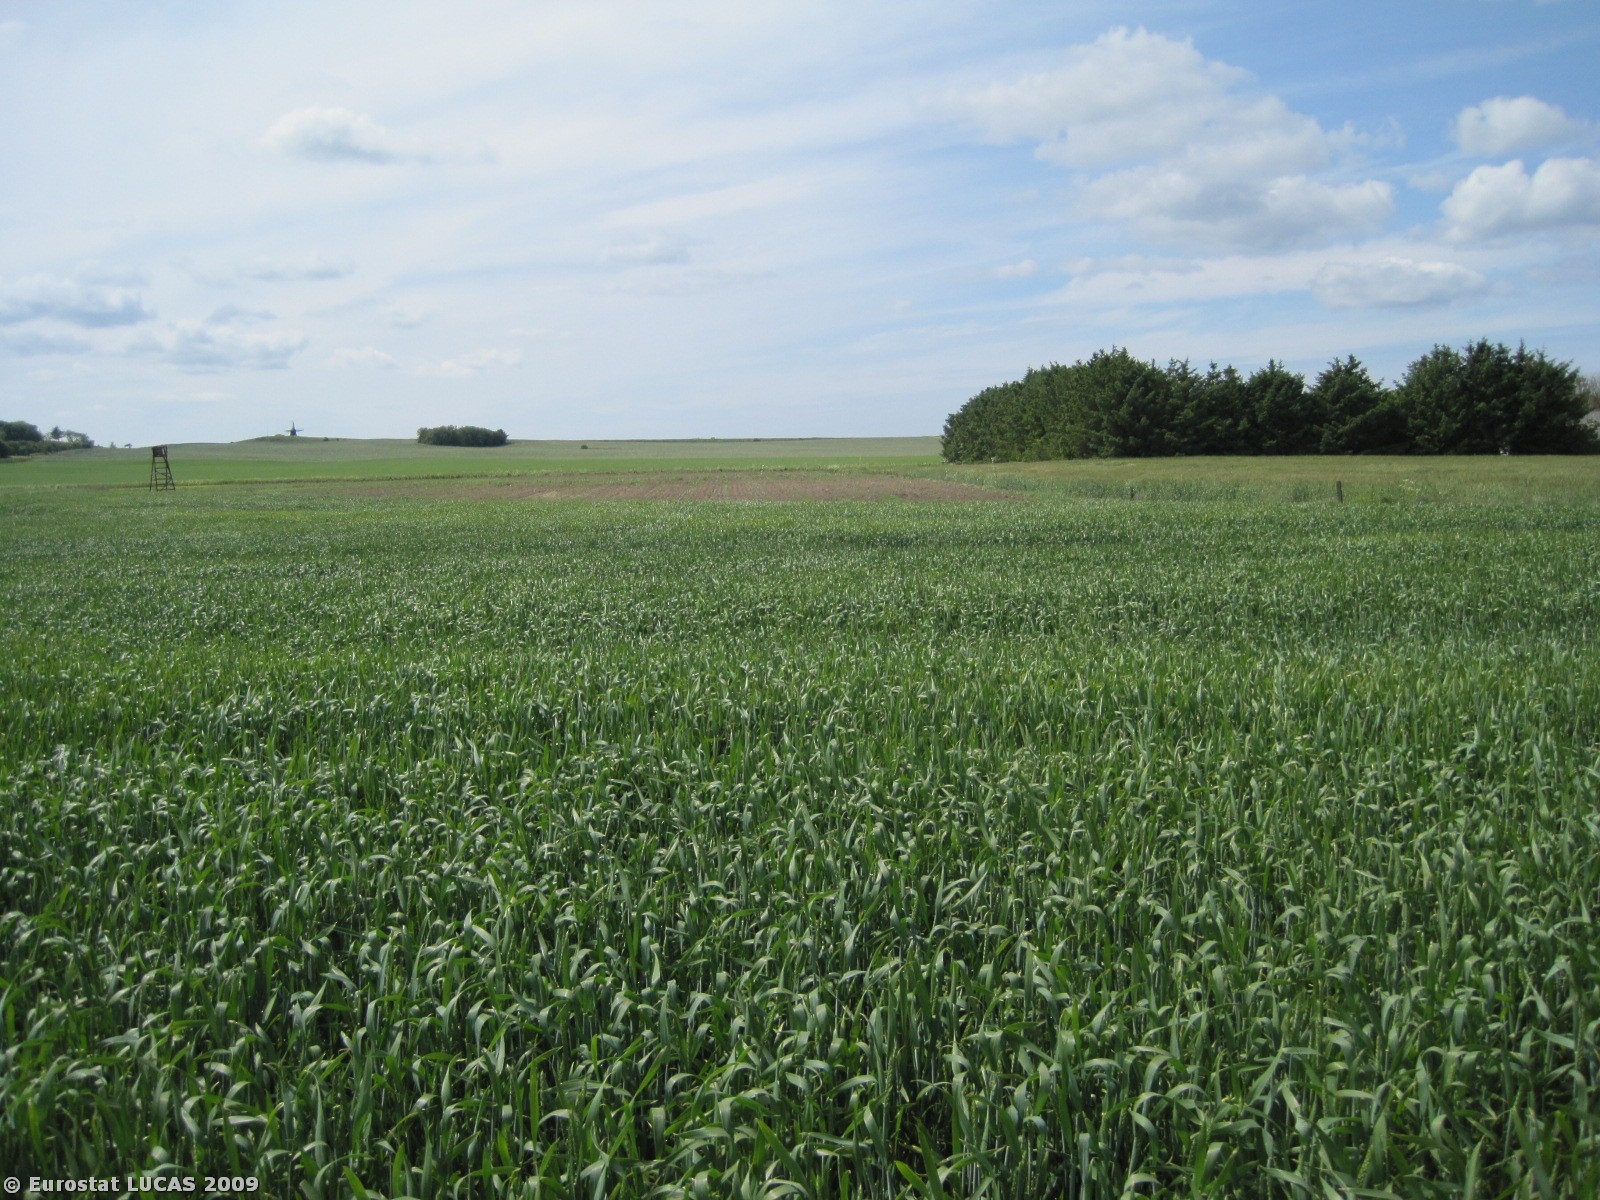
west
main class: Cropland
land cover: Common wheat
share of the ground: > 75 %
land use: Agriculture (excluding fallow land and kitchen gardens)
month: June
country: DK
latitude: 57.3741
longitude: 9.8174
